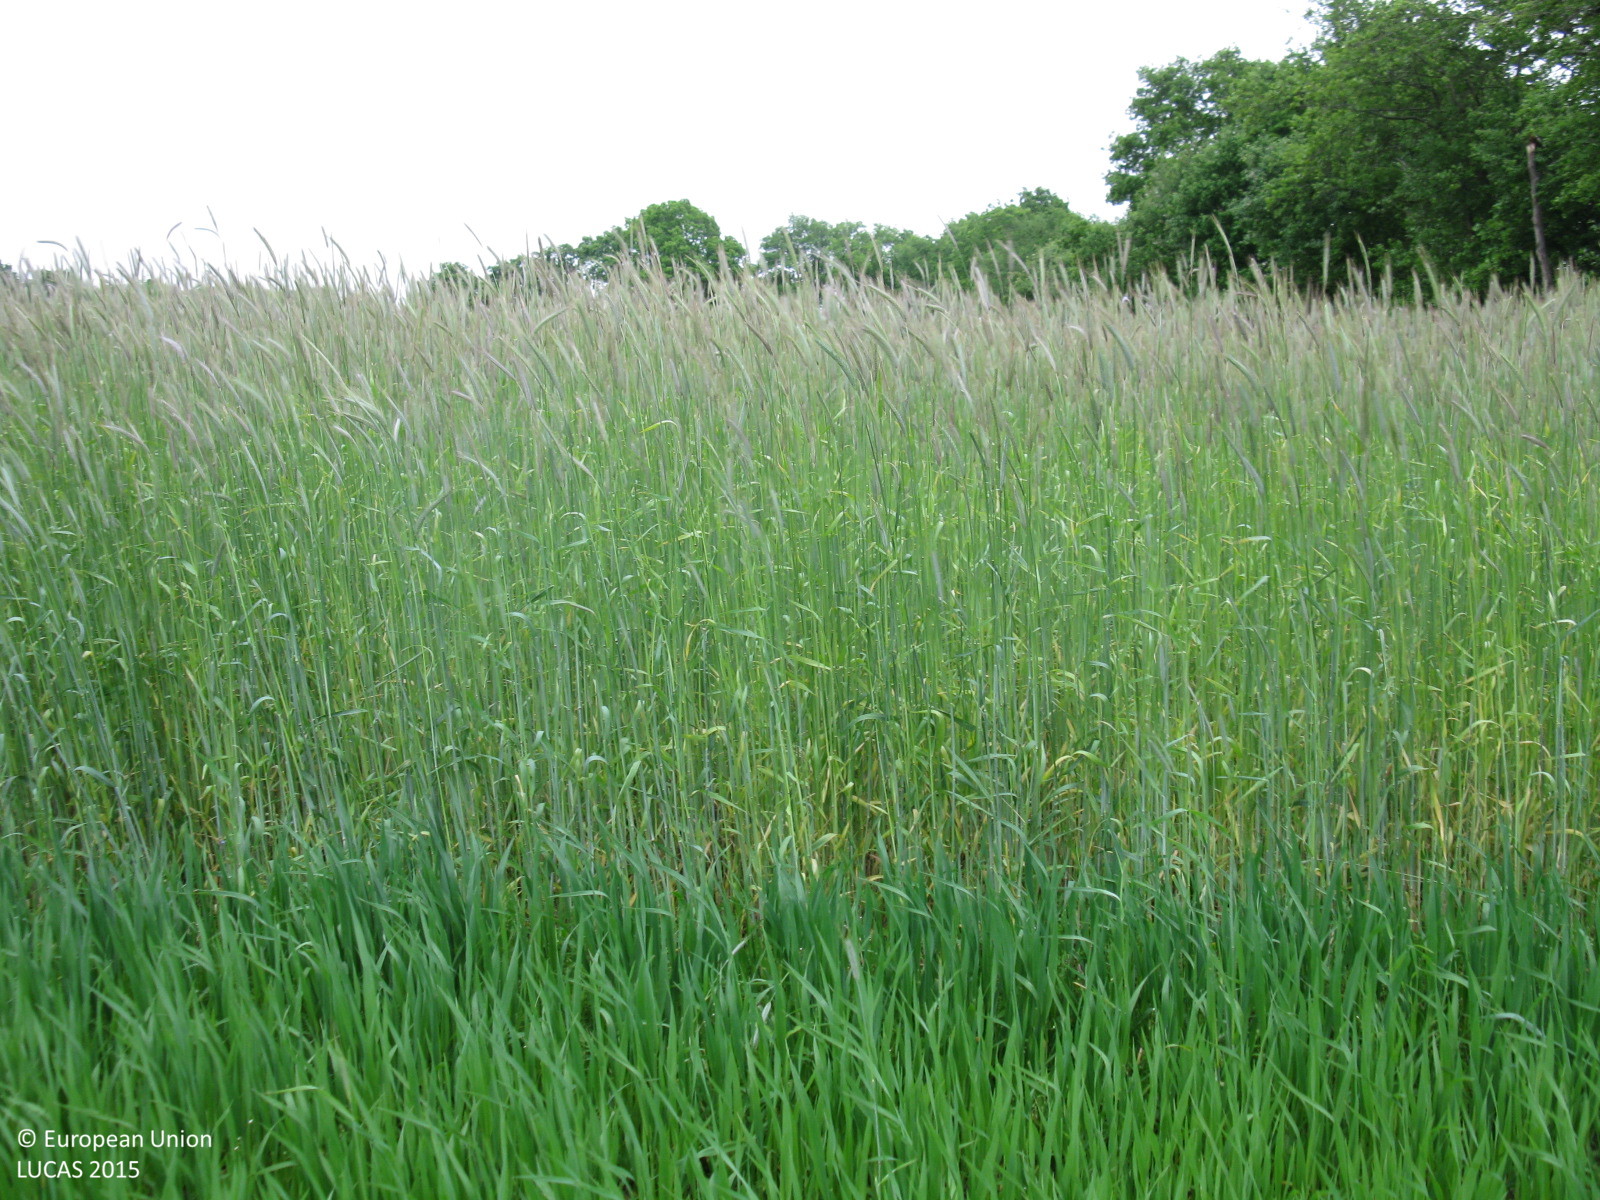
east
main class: Cropland
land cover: Oats
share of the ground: > 75 %
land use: Agriculture (excluding fallow land and kitchen gardens)
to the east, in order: Oats; Rye; Broadleaved woodland; Grassland without tree/shrub cover; Paved roads, cycling and walking lanes; Grassland without tree/shrub cover; Broadleaved woodland; Triticale
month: June
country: DE
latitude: 53.0322
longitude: 7.3910
